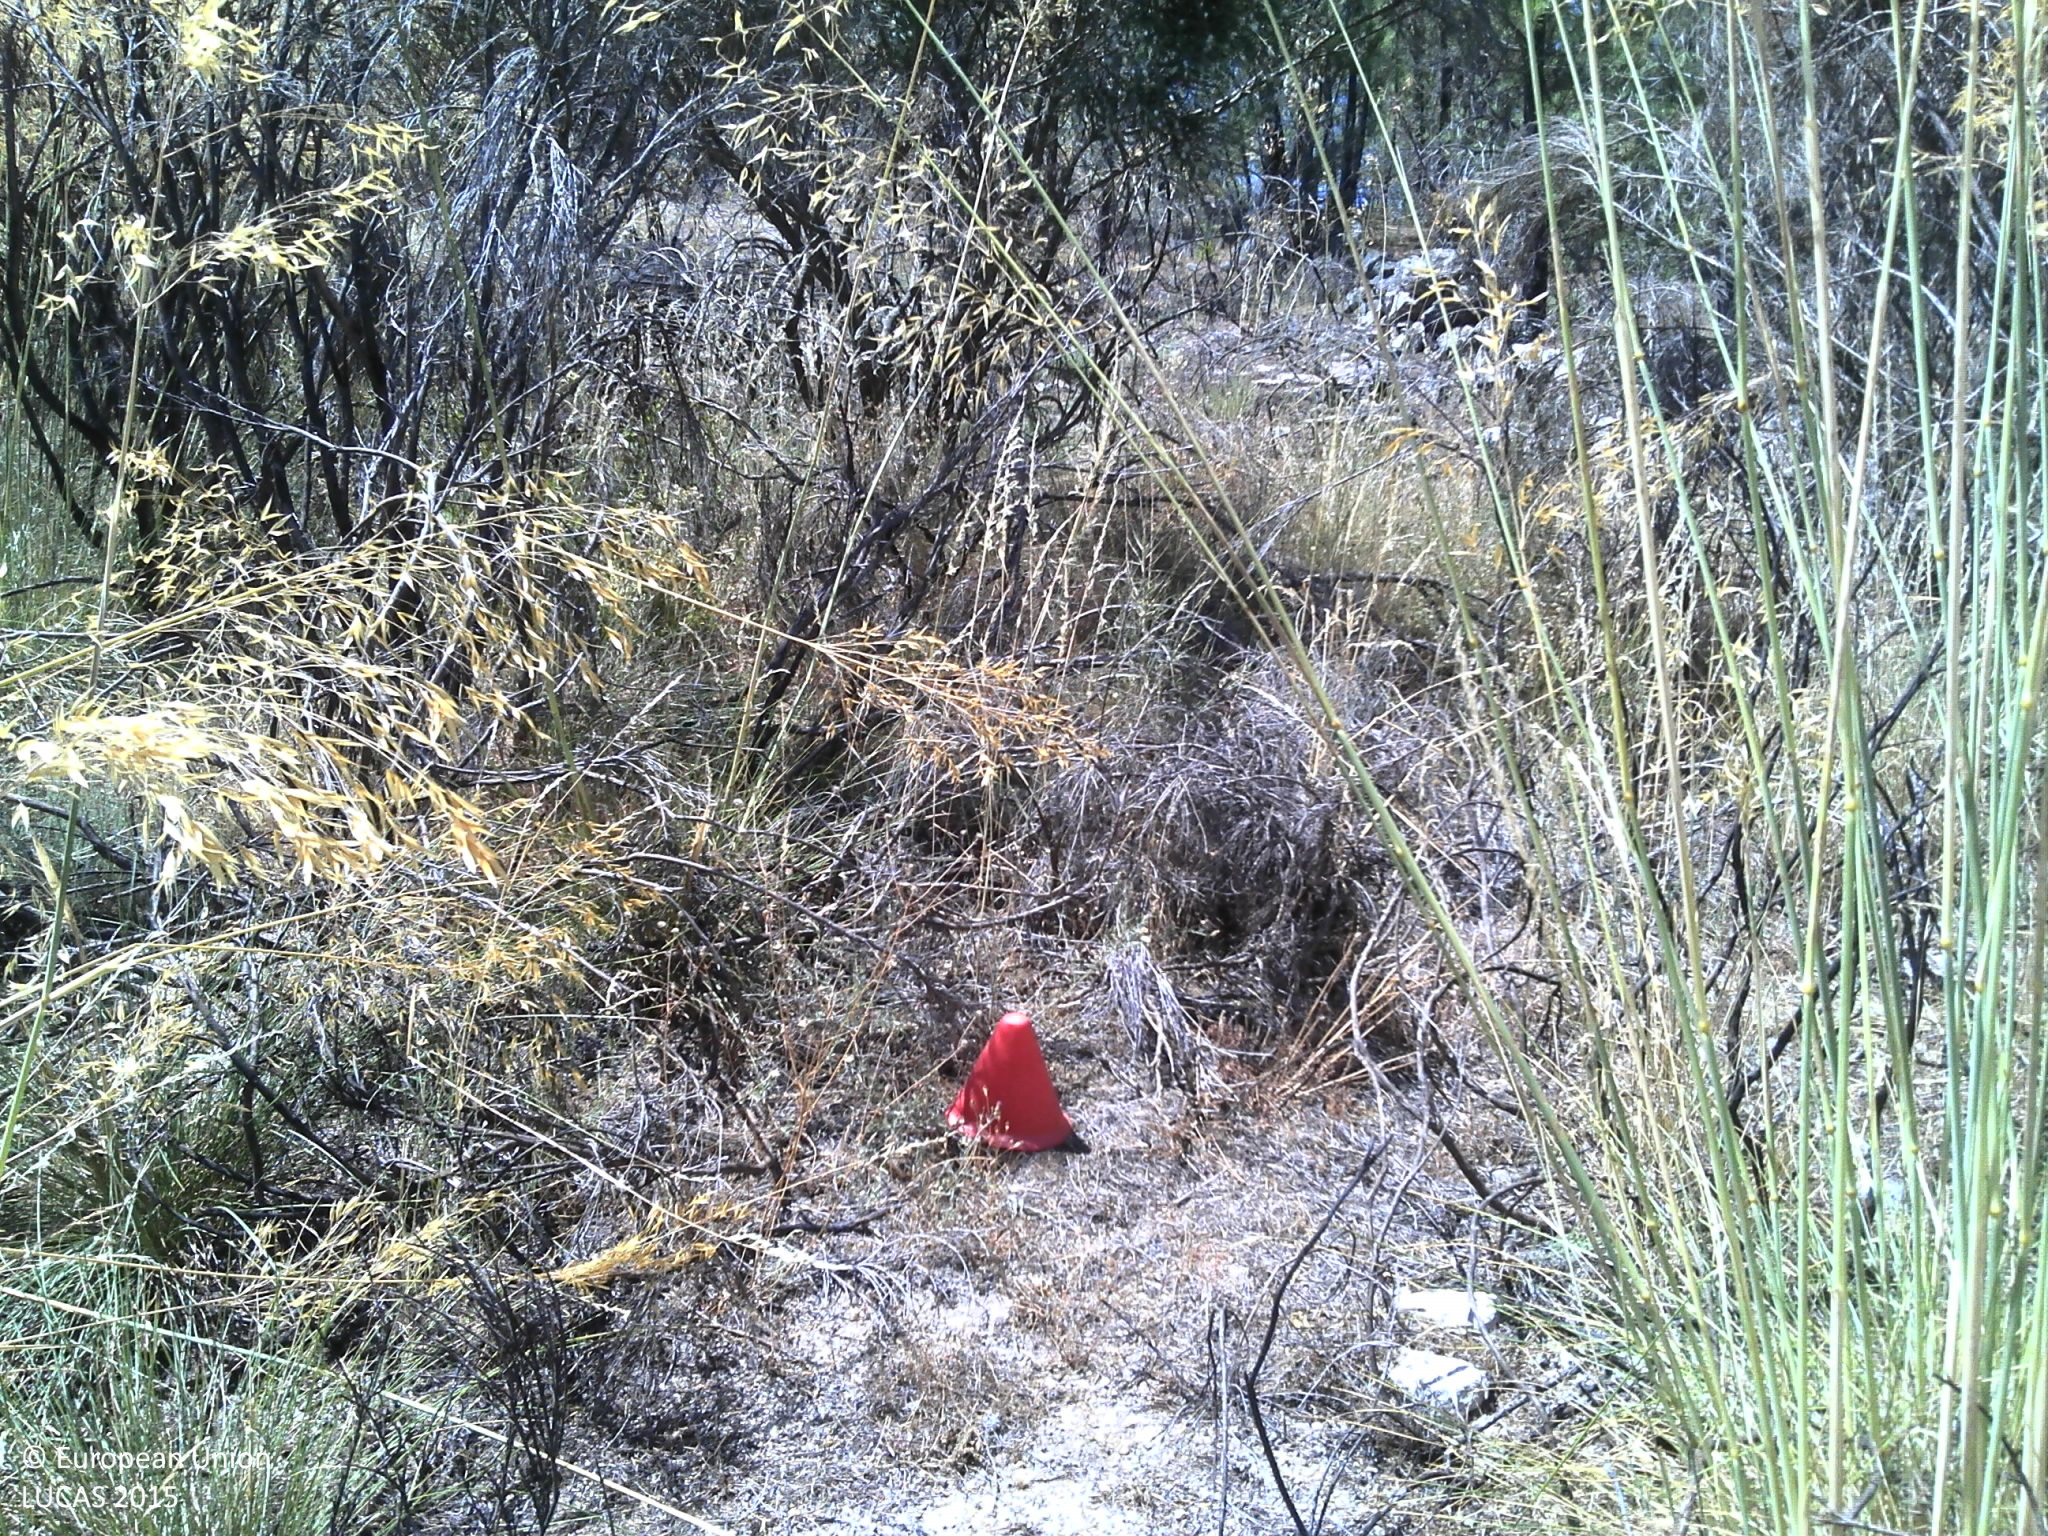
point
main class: Grassland
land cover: Spontaneously vegetated surfaces
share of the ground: 50 - 75 %
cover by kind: herbaceous plants 60 %, unconsolidated bare surface 40 %
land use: Semi-natural and natural areas not in use
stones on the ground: 10 - 25 %
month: June
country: PT
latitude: 40.7350
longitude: -7.3641
